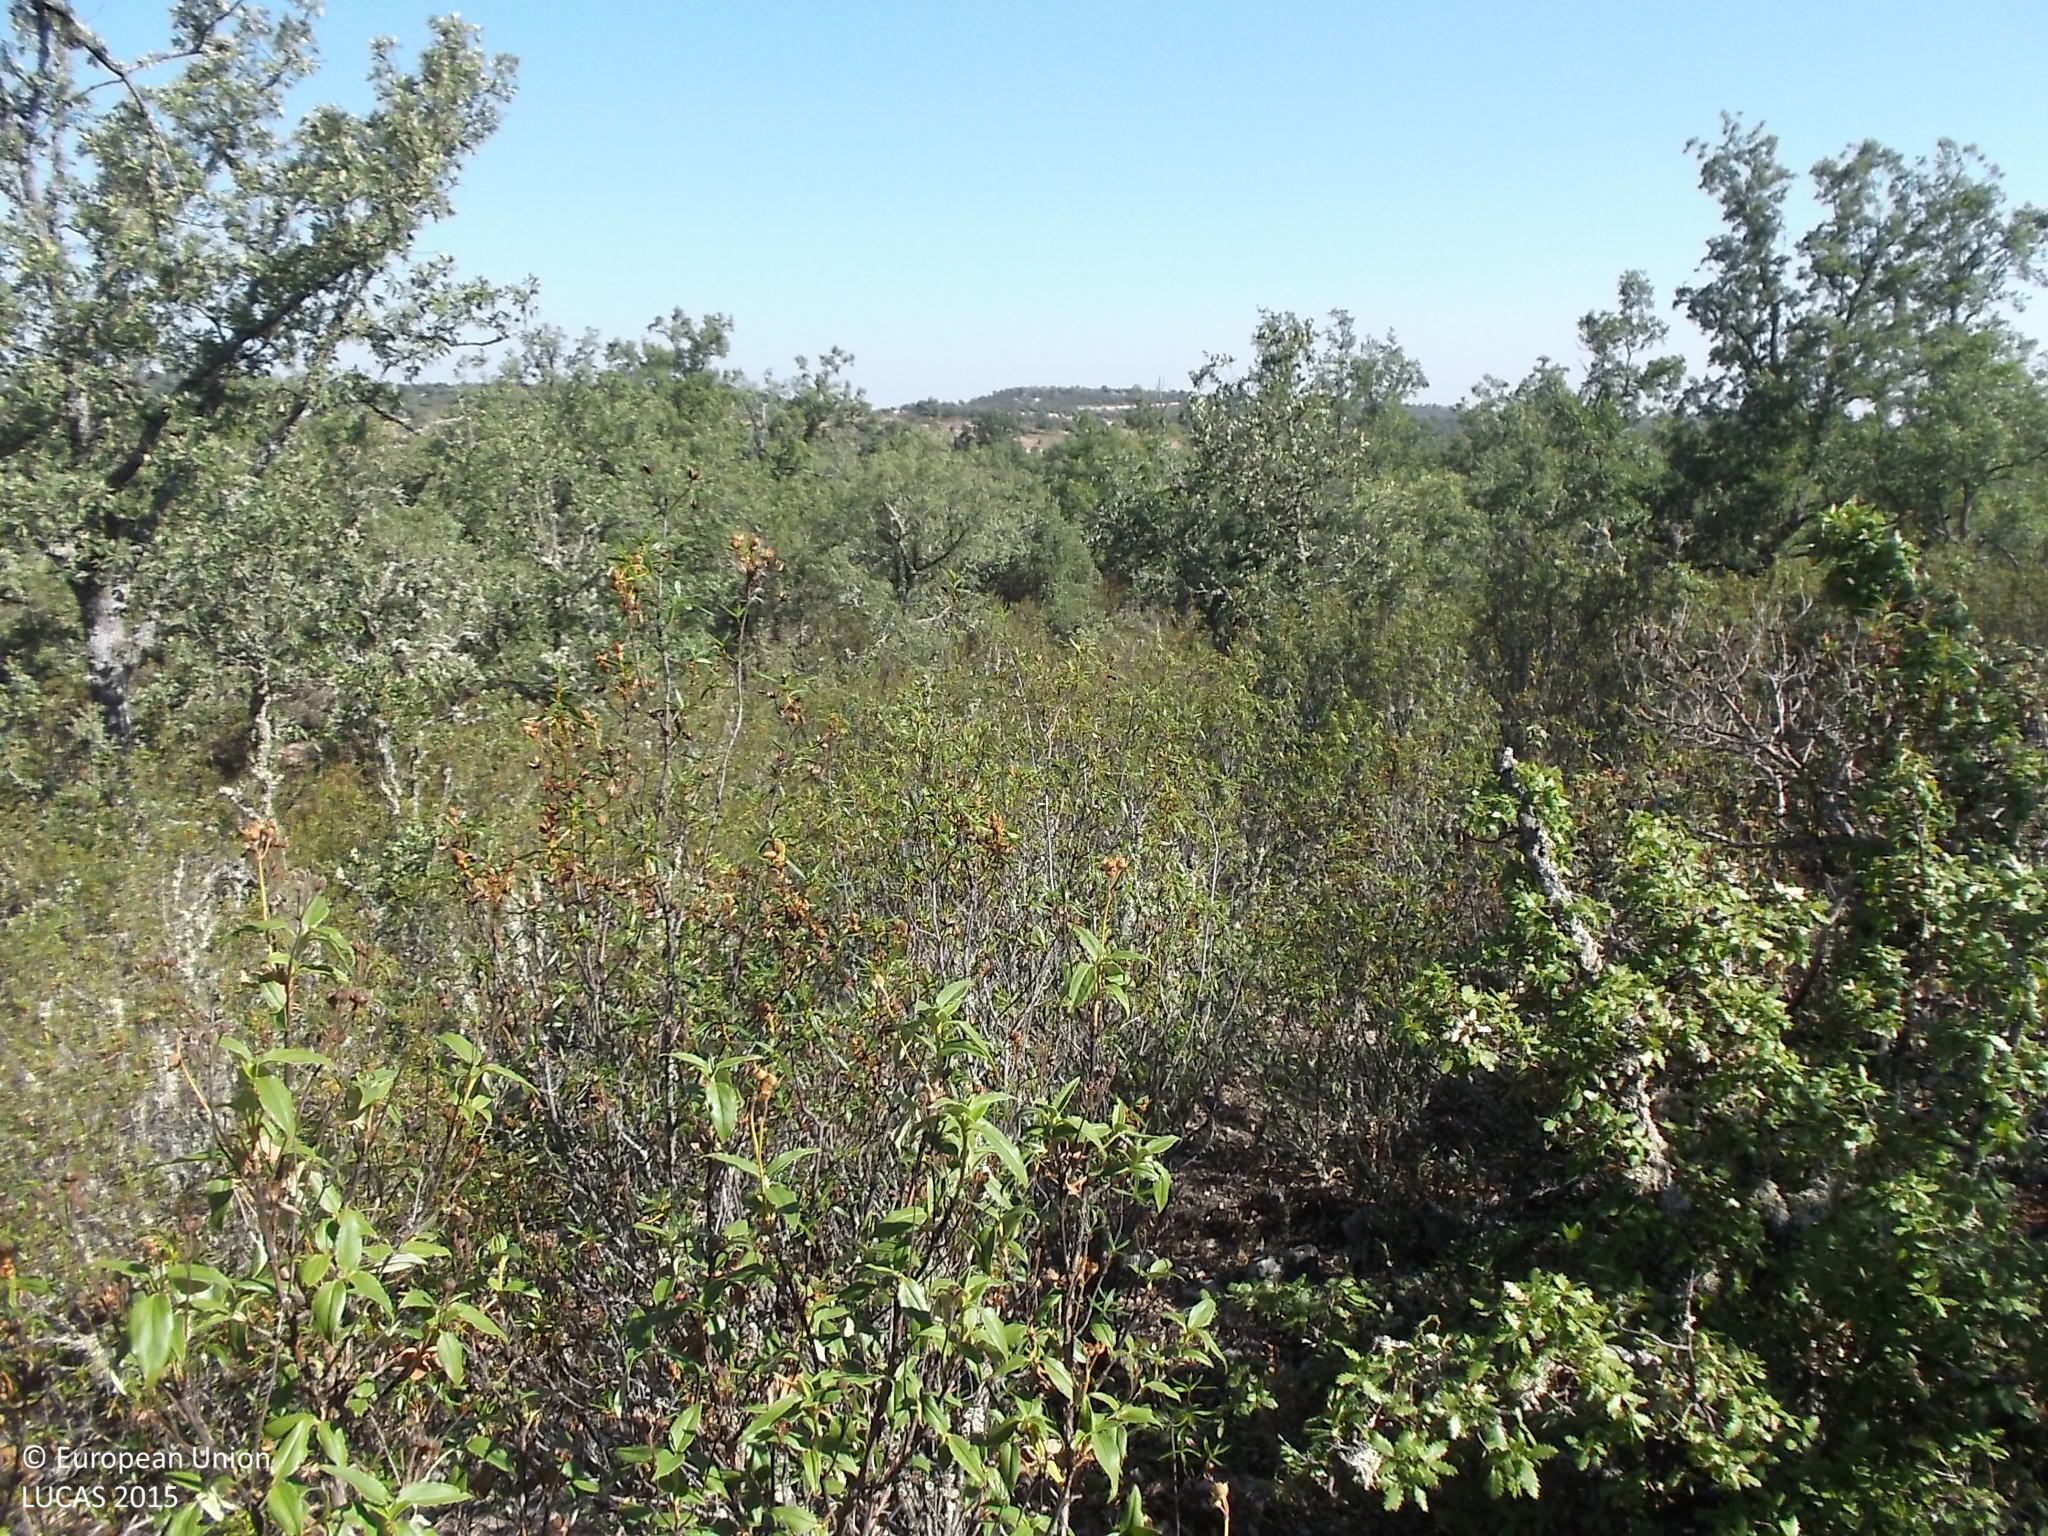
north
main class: Woodland
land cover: Broadleaved woodland
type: broadleaved evergreen forest
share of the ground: 10 - 25 %
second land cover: Shrubland without tree cover
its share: 50 - 75 %
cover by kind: shrubs 80 %, broadleaved forest trees 20 %
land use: Forestry
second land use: Agriculture (excluding fallow land and kitchen gardens)
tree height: < 5 m
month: July
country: ES
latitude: 41.2889
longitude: -5.8352
